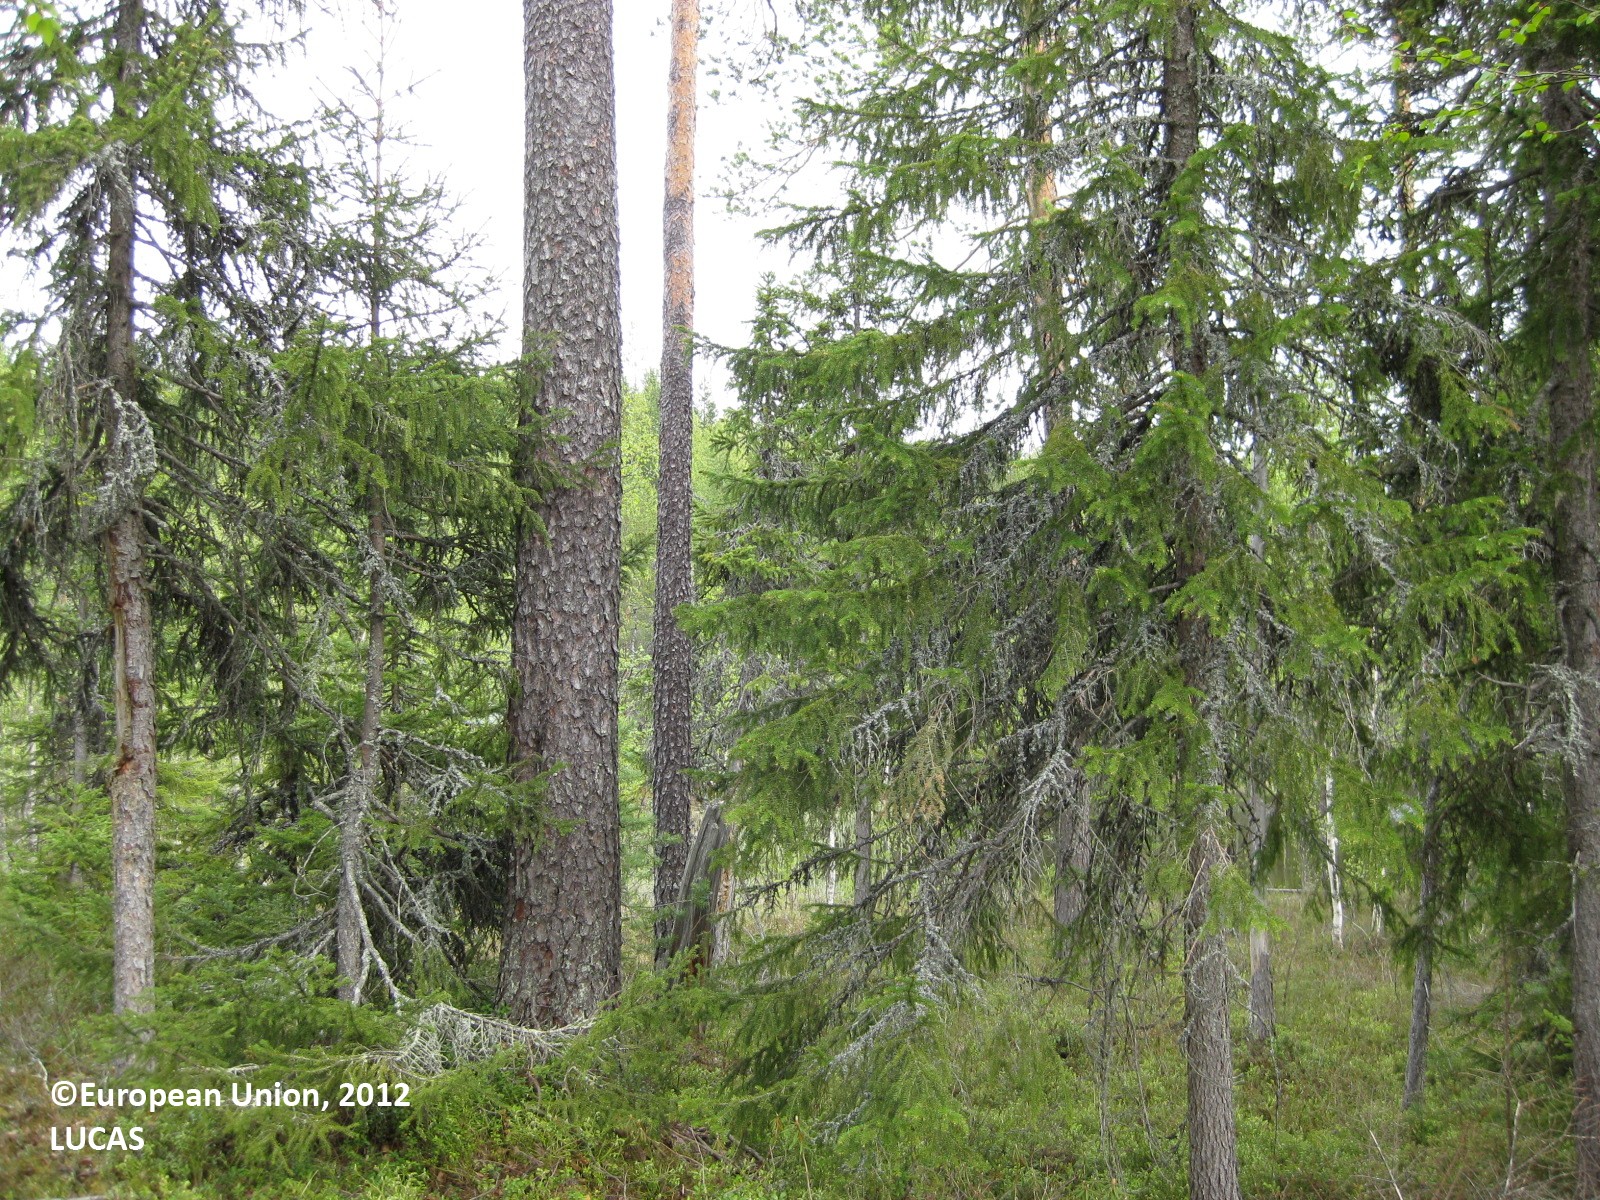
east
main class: Woodland
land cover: Pine dominated mixed woodland
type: boreal forest
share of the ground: > 75 %
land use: Forestry
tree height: > 5 m
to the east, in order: Pine dominated mixed woodland; Broadleaved woodland; Ditches and canals; Pine dominated mixed woodland; Artificial constructions in urban areas; Pine dominated mixed woodland
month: June
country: FI
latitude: 65.3943
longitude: 29.2389
